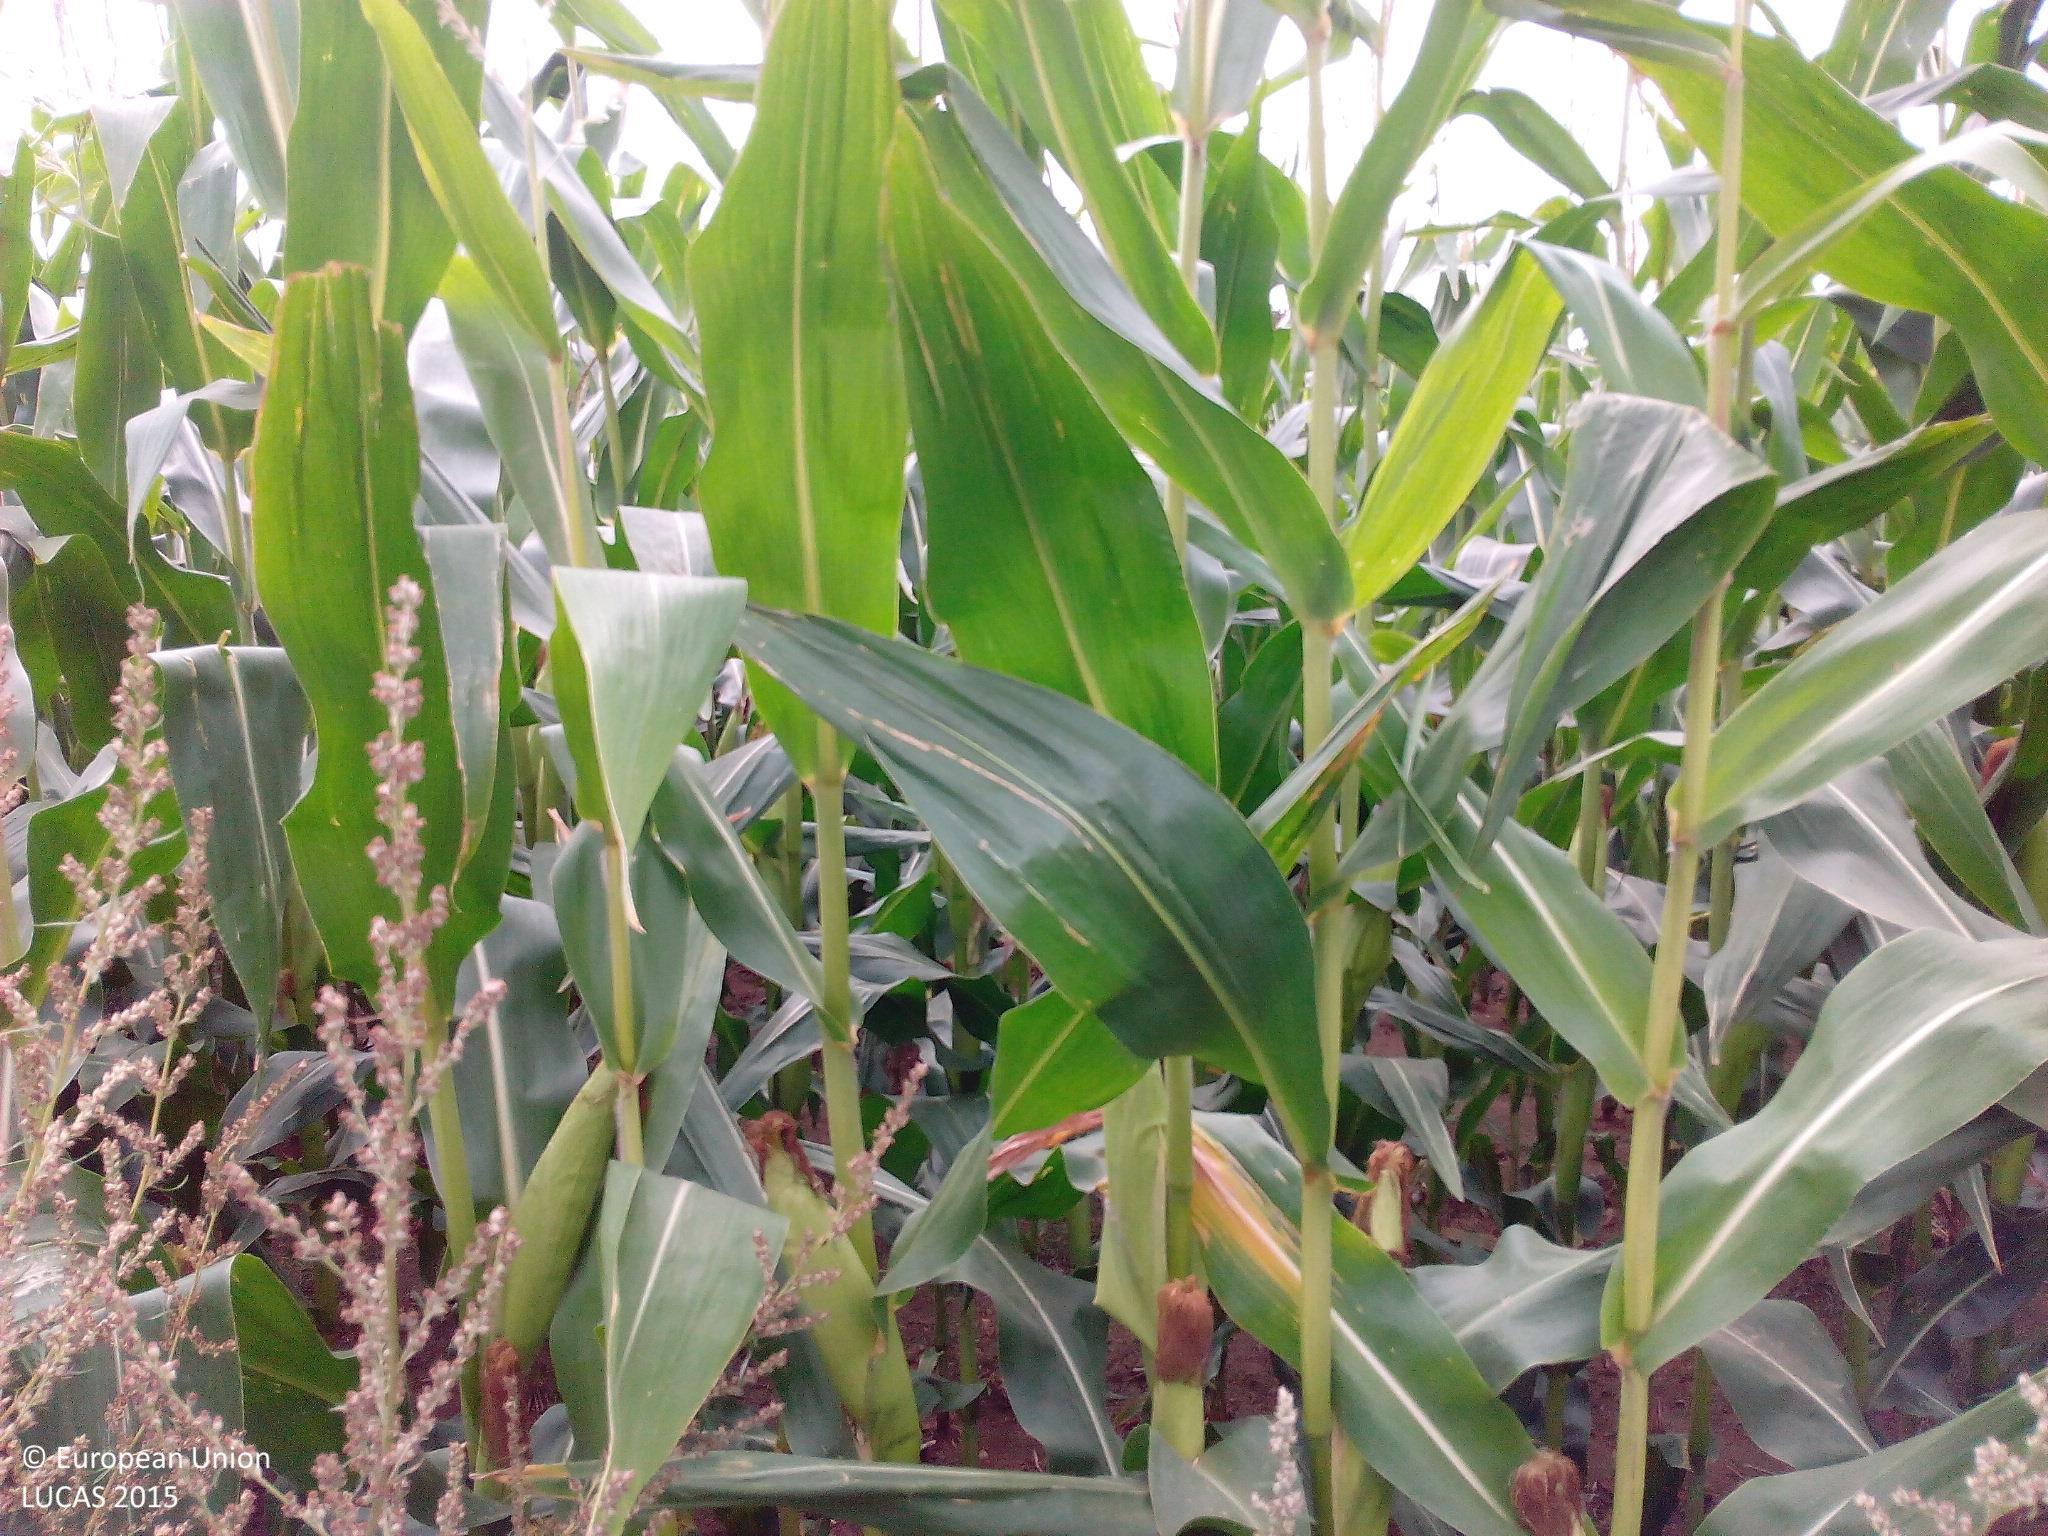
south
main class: Cropland
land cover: Maize
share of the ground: > 75 %
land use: Agriculture (excluding fallow land and kitchen gardens)
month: August
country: DE
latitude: 53.8775
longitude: 12.6003
